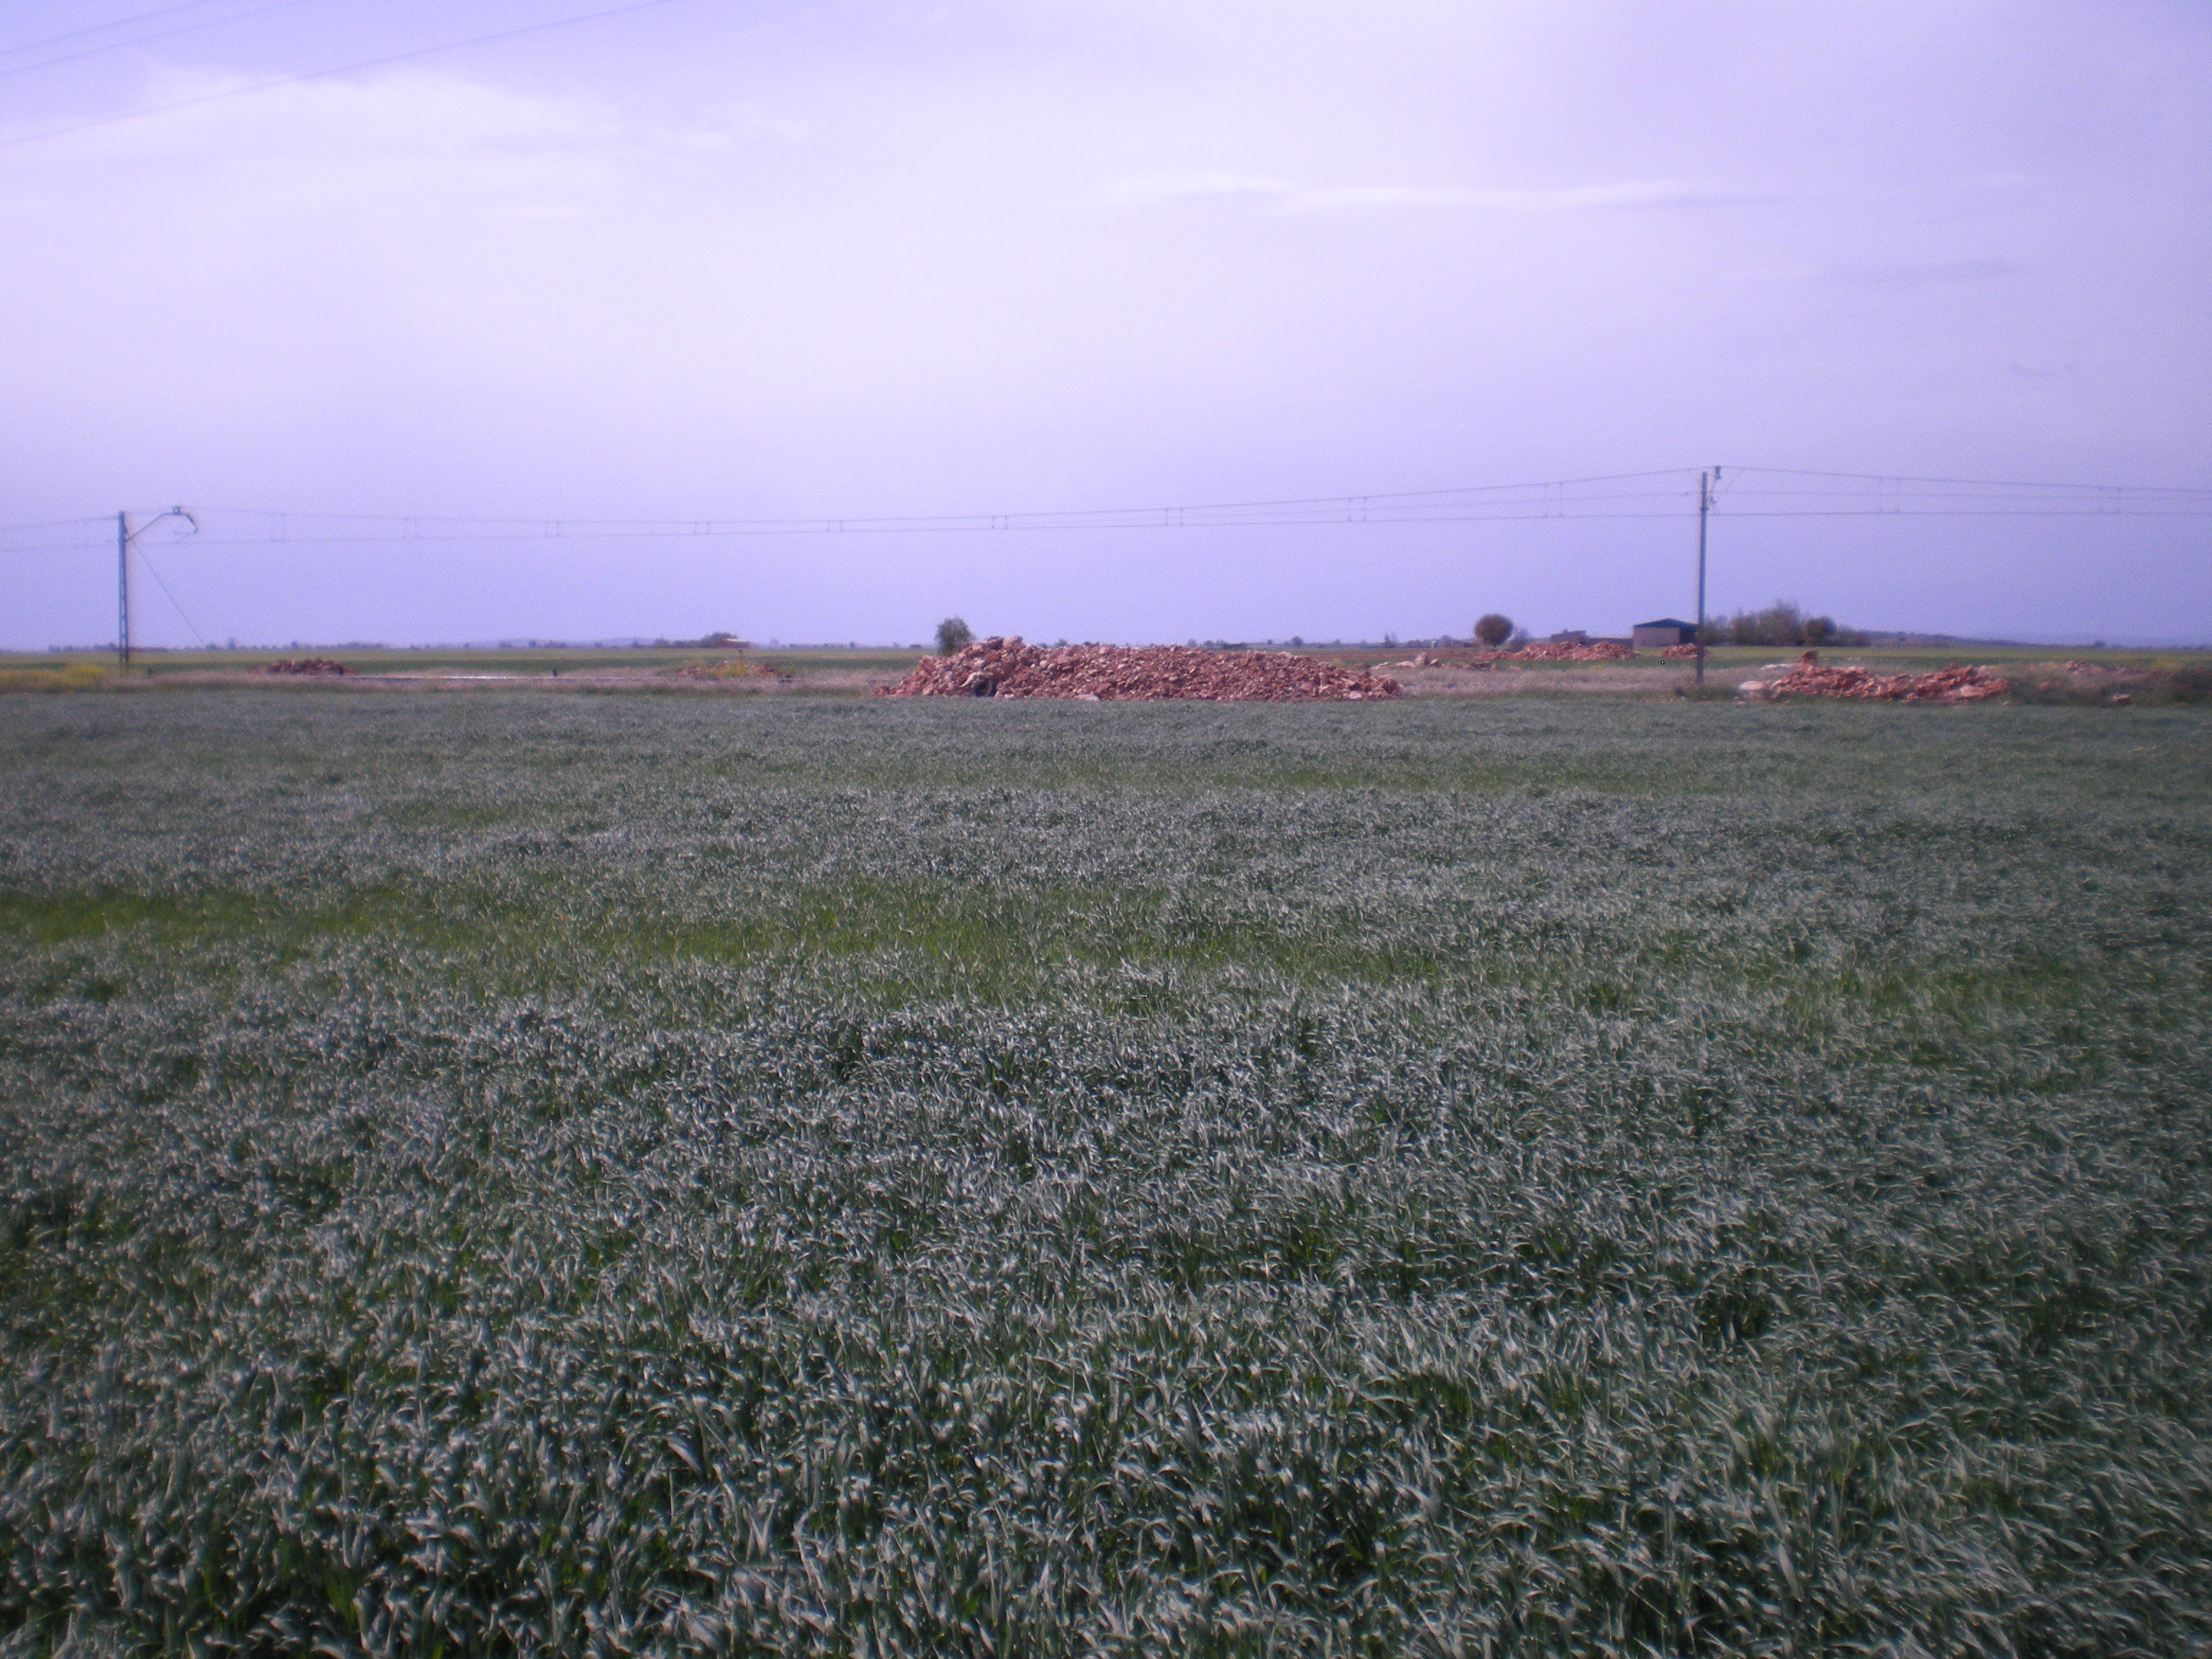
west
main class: Cropland
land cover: Barley
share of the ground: > 75 %
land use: Agriculture (excluding fallow land and kitchen gardens)
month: April
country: ES
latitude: 39.0174
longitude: -3.6343
